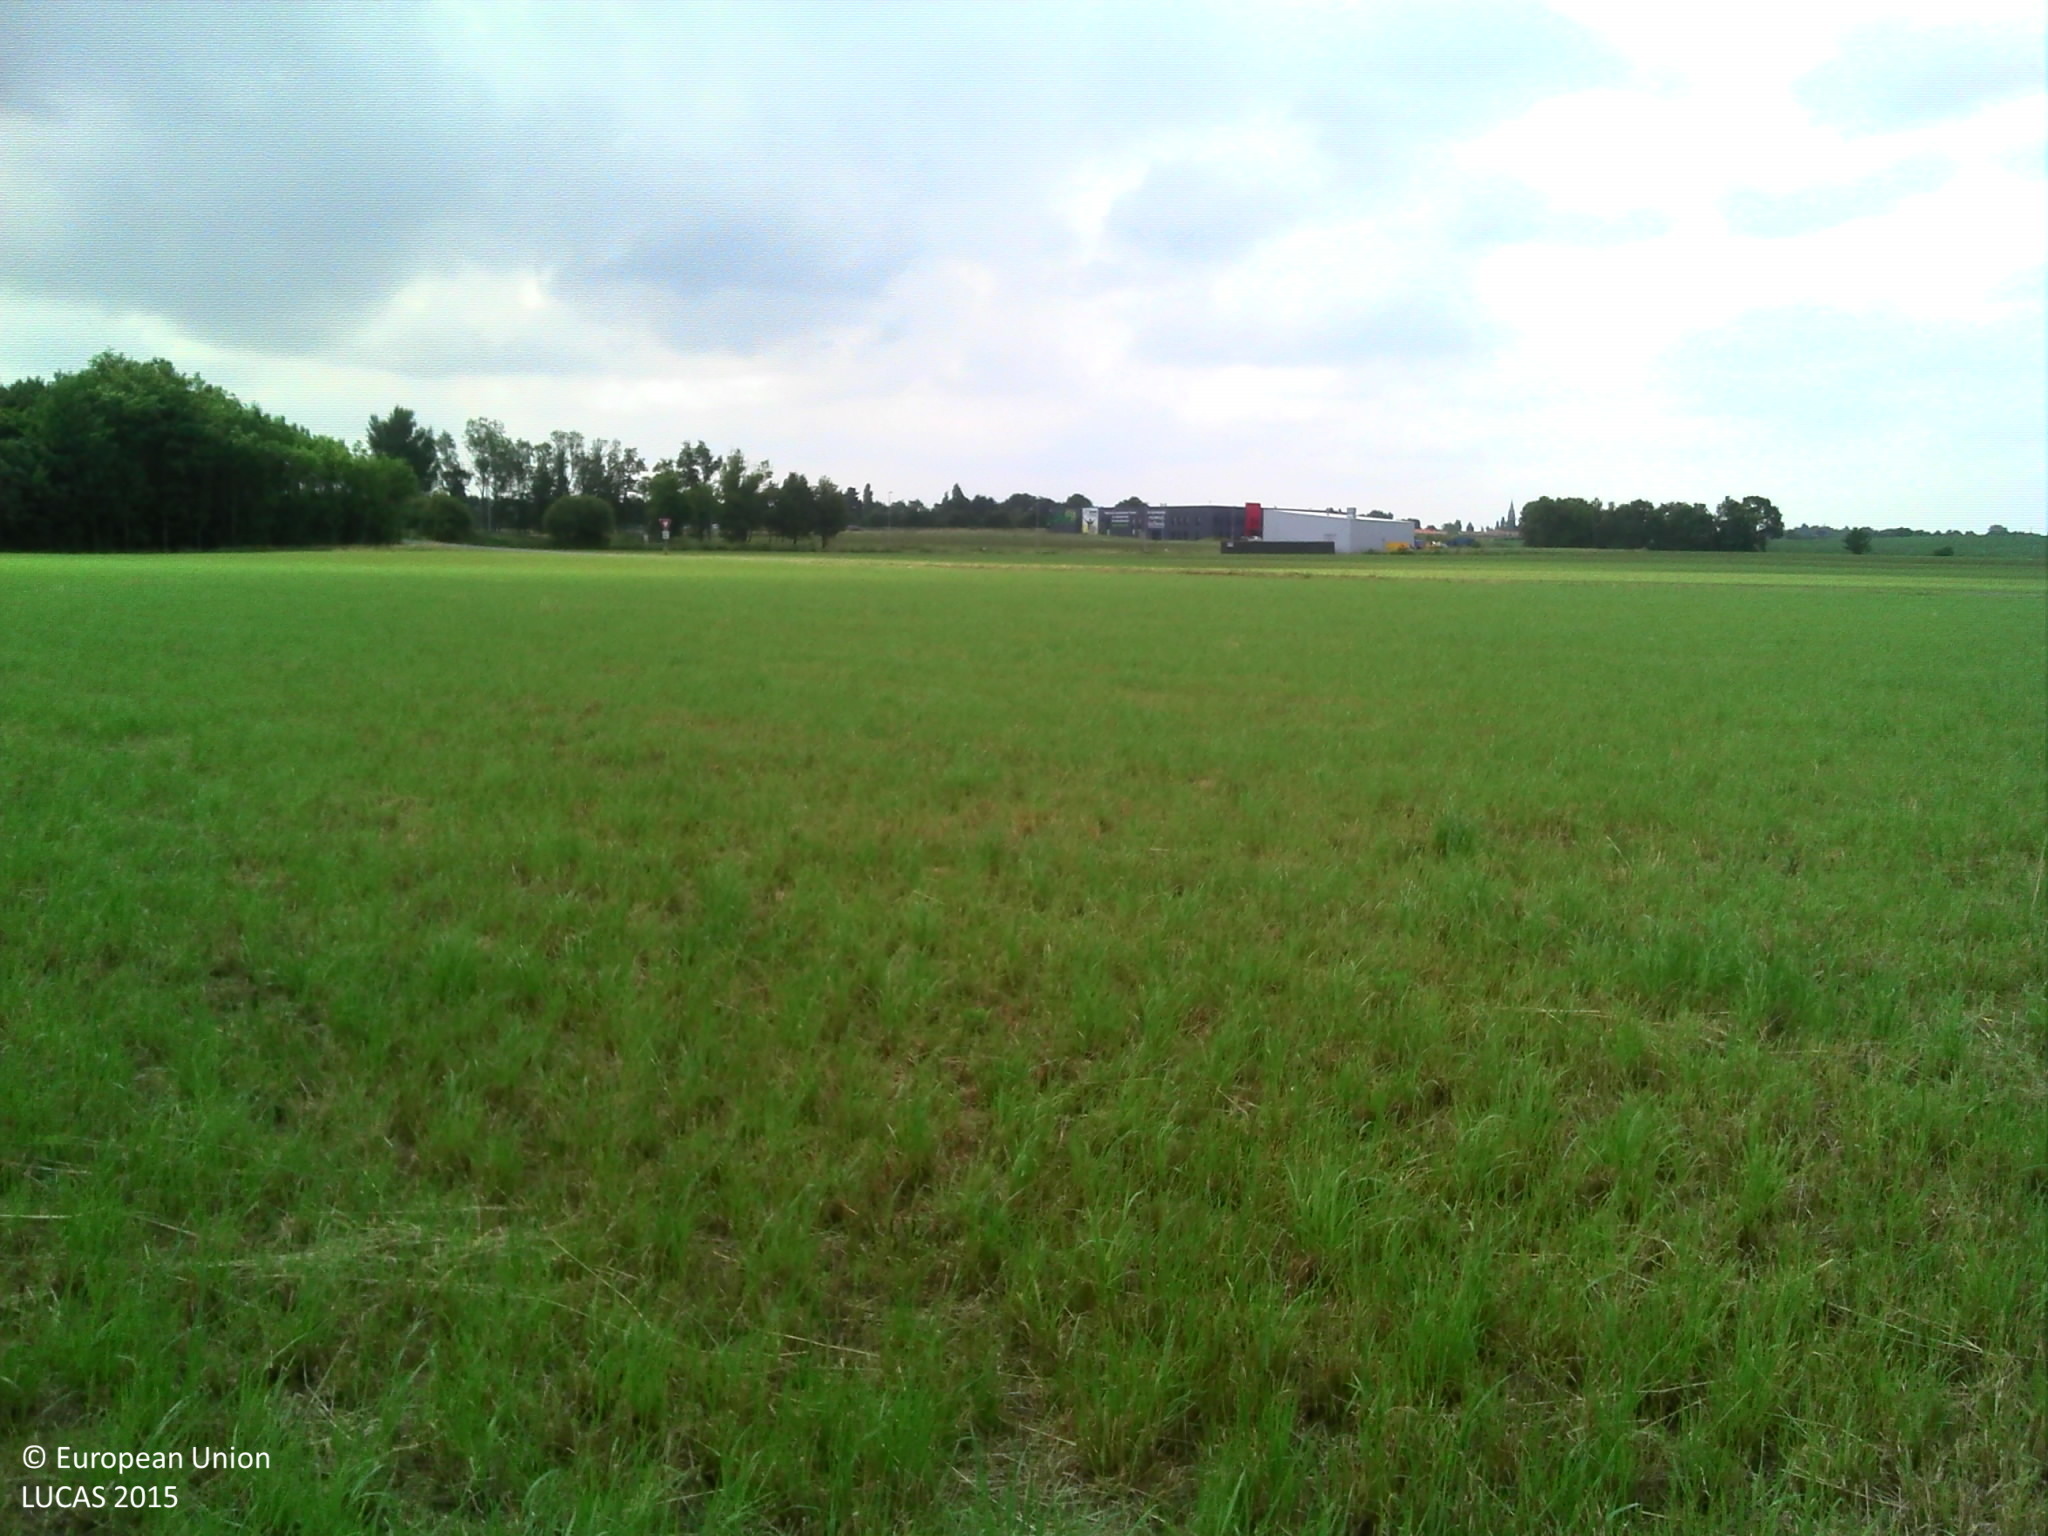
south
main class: Cropland
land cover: Temporary grasslands
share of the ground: > 75 %
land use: Agriculture (excluding fallow land and kitchen gardens)
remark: Harvested field
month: June
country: FR
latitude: 46.9243
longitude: -1.3718
